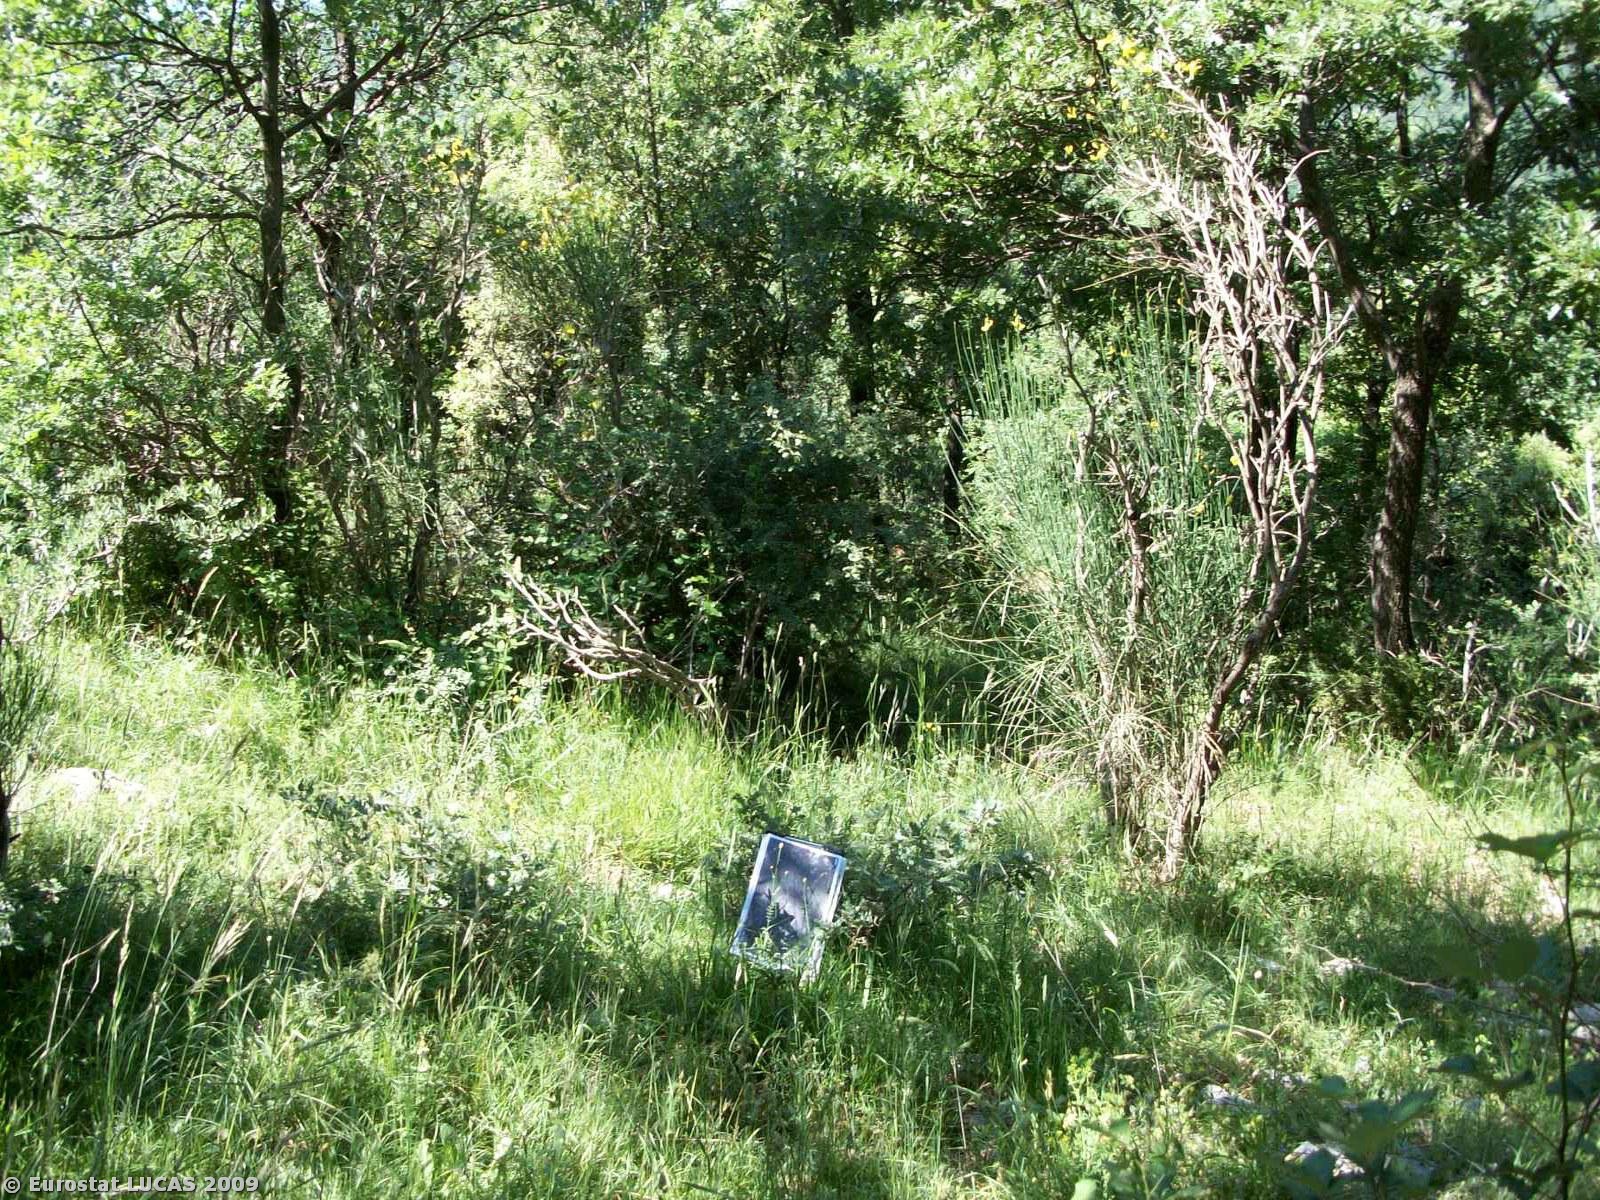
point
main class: Woodland
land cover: Broadleaved woodland
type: mesophytic deciduous forest
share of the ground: > 75 %
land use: Agriculture (excluding fallow land and kitchen gardens)
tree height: > 5 m
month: June
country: IT
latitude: 39.7009
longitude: 16.0251
